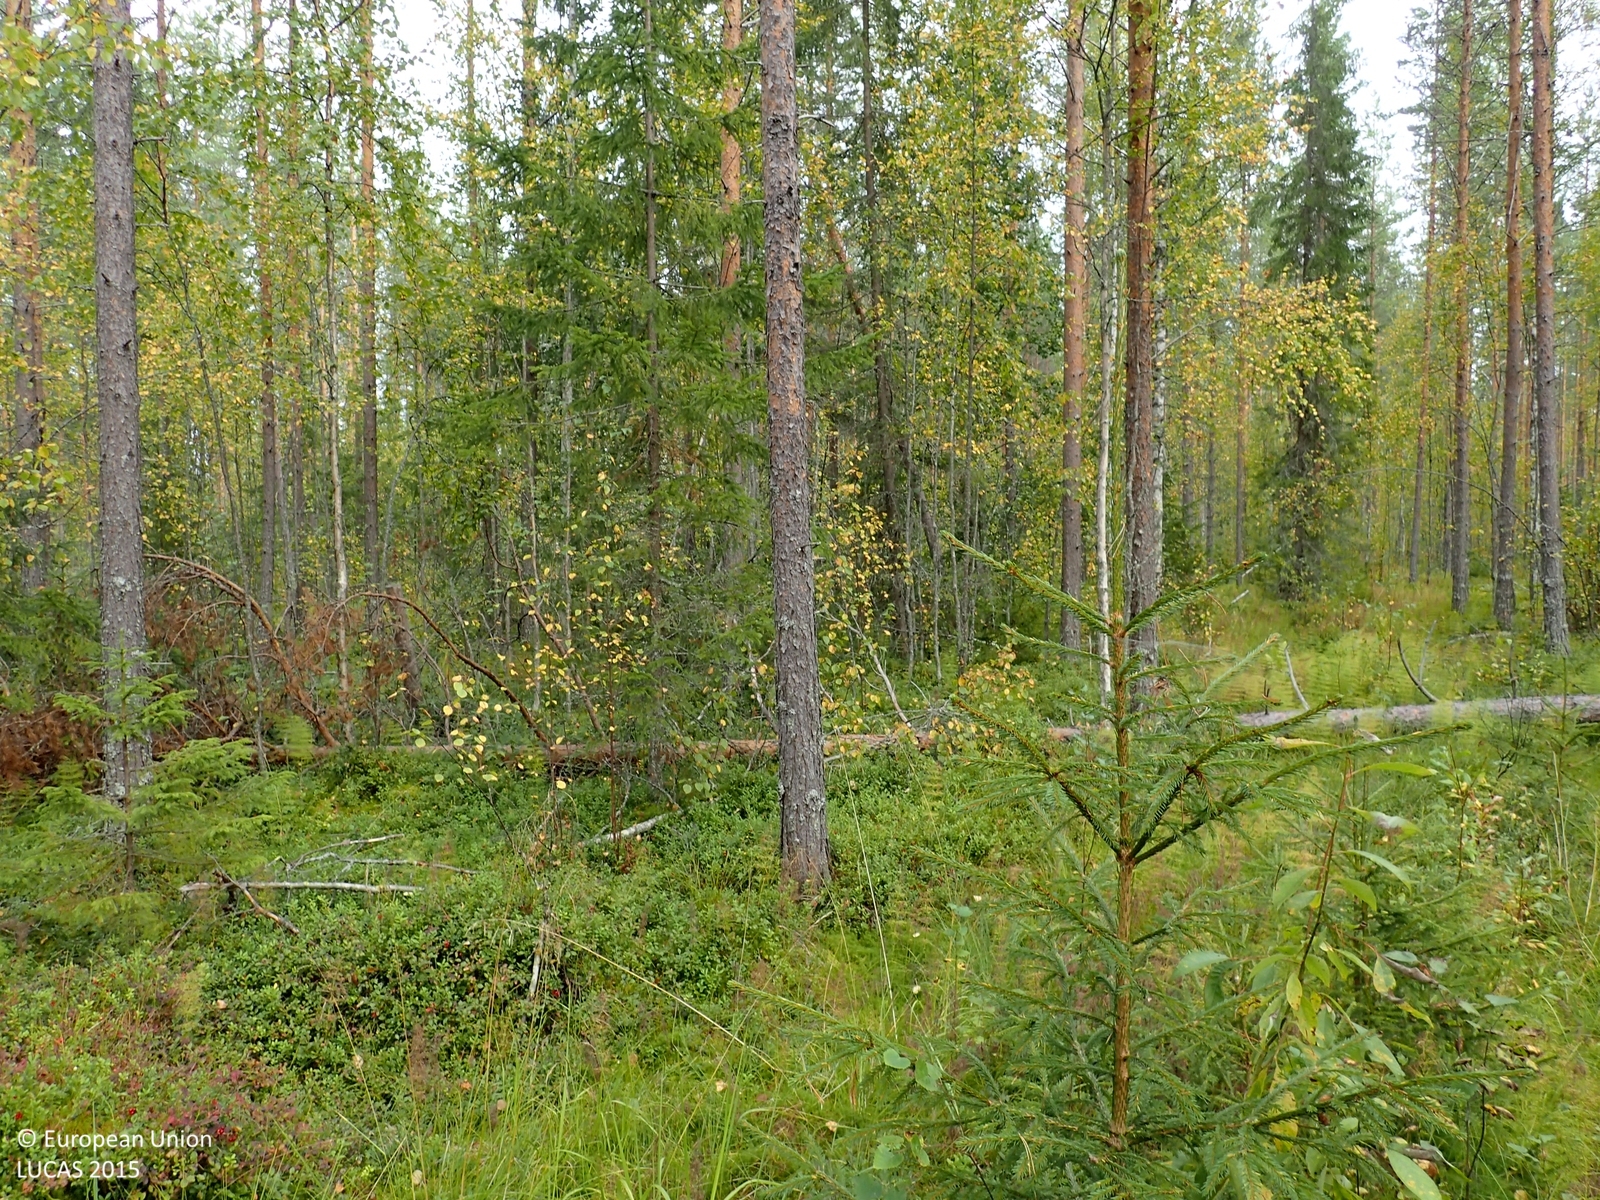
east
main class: Woodland
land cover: Pine dominated mixed woodland
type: boreal forest
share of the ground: 50 - 75 %
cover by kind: coniferous forest trees 50 %, broadleaved forest trees 20 %, shrubs 20 %, herbaceous plants 5 %, lichens and mosses 5 %
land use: Forestry
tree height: > 5 m
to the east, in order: Pine dominated mixed woodland; Ditches and canals; Broadleaved woodland; Spruce dominated mixed woodland
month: September
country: FI
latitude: 62.9560
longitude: 26.1104
